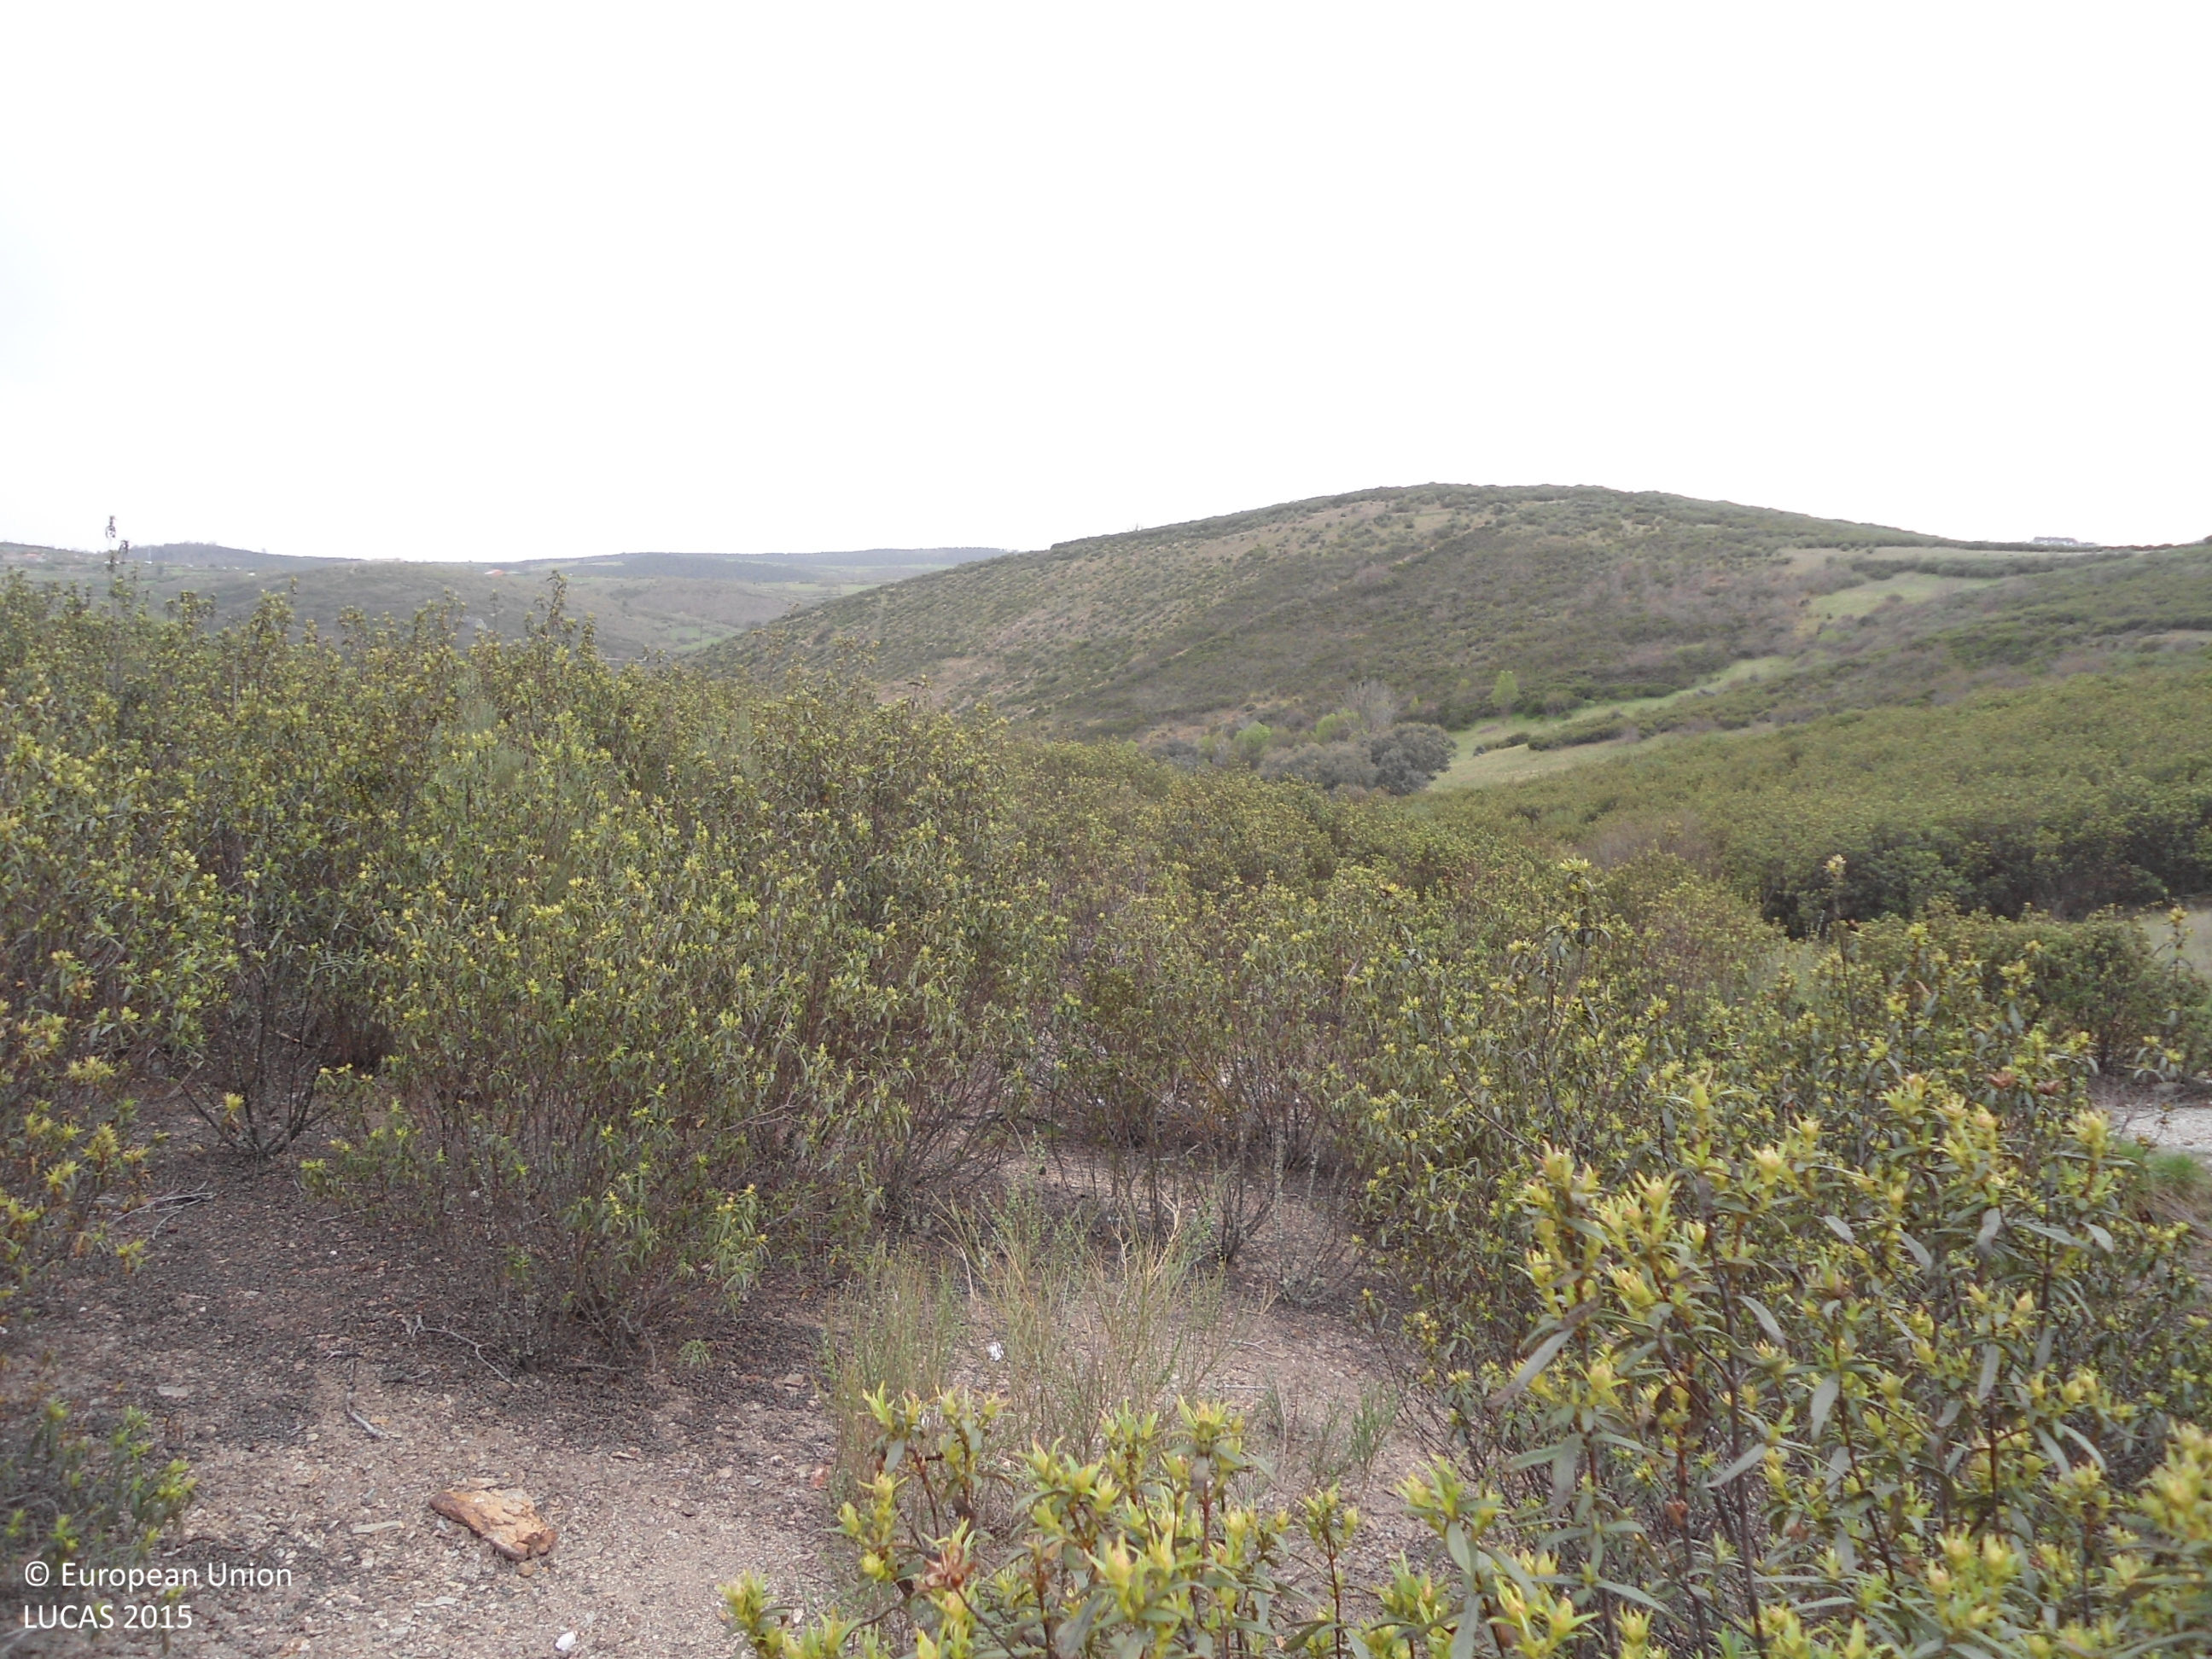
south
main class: Shrubland
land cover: Shrubland without tree cover
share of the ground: > 75 %
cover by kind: shrubs 95 %, consolidated bare surface 5 %
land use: Semi-natural and natural areas not in use
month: April
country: ES
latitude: 41.7893
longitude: -6.4836
